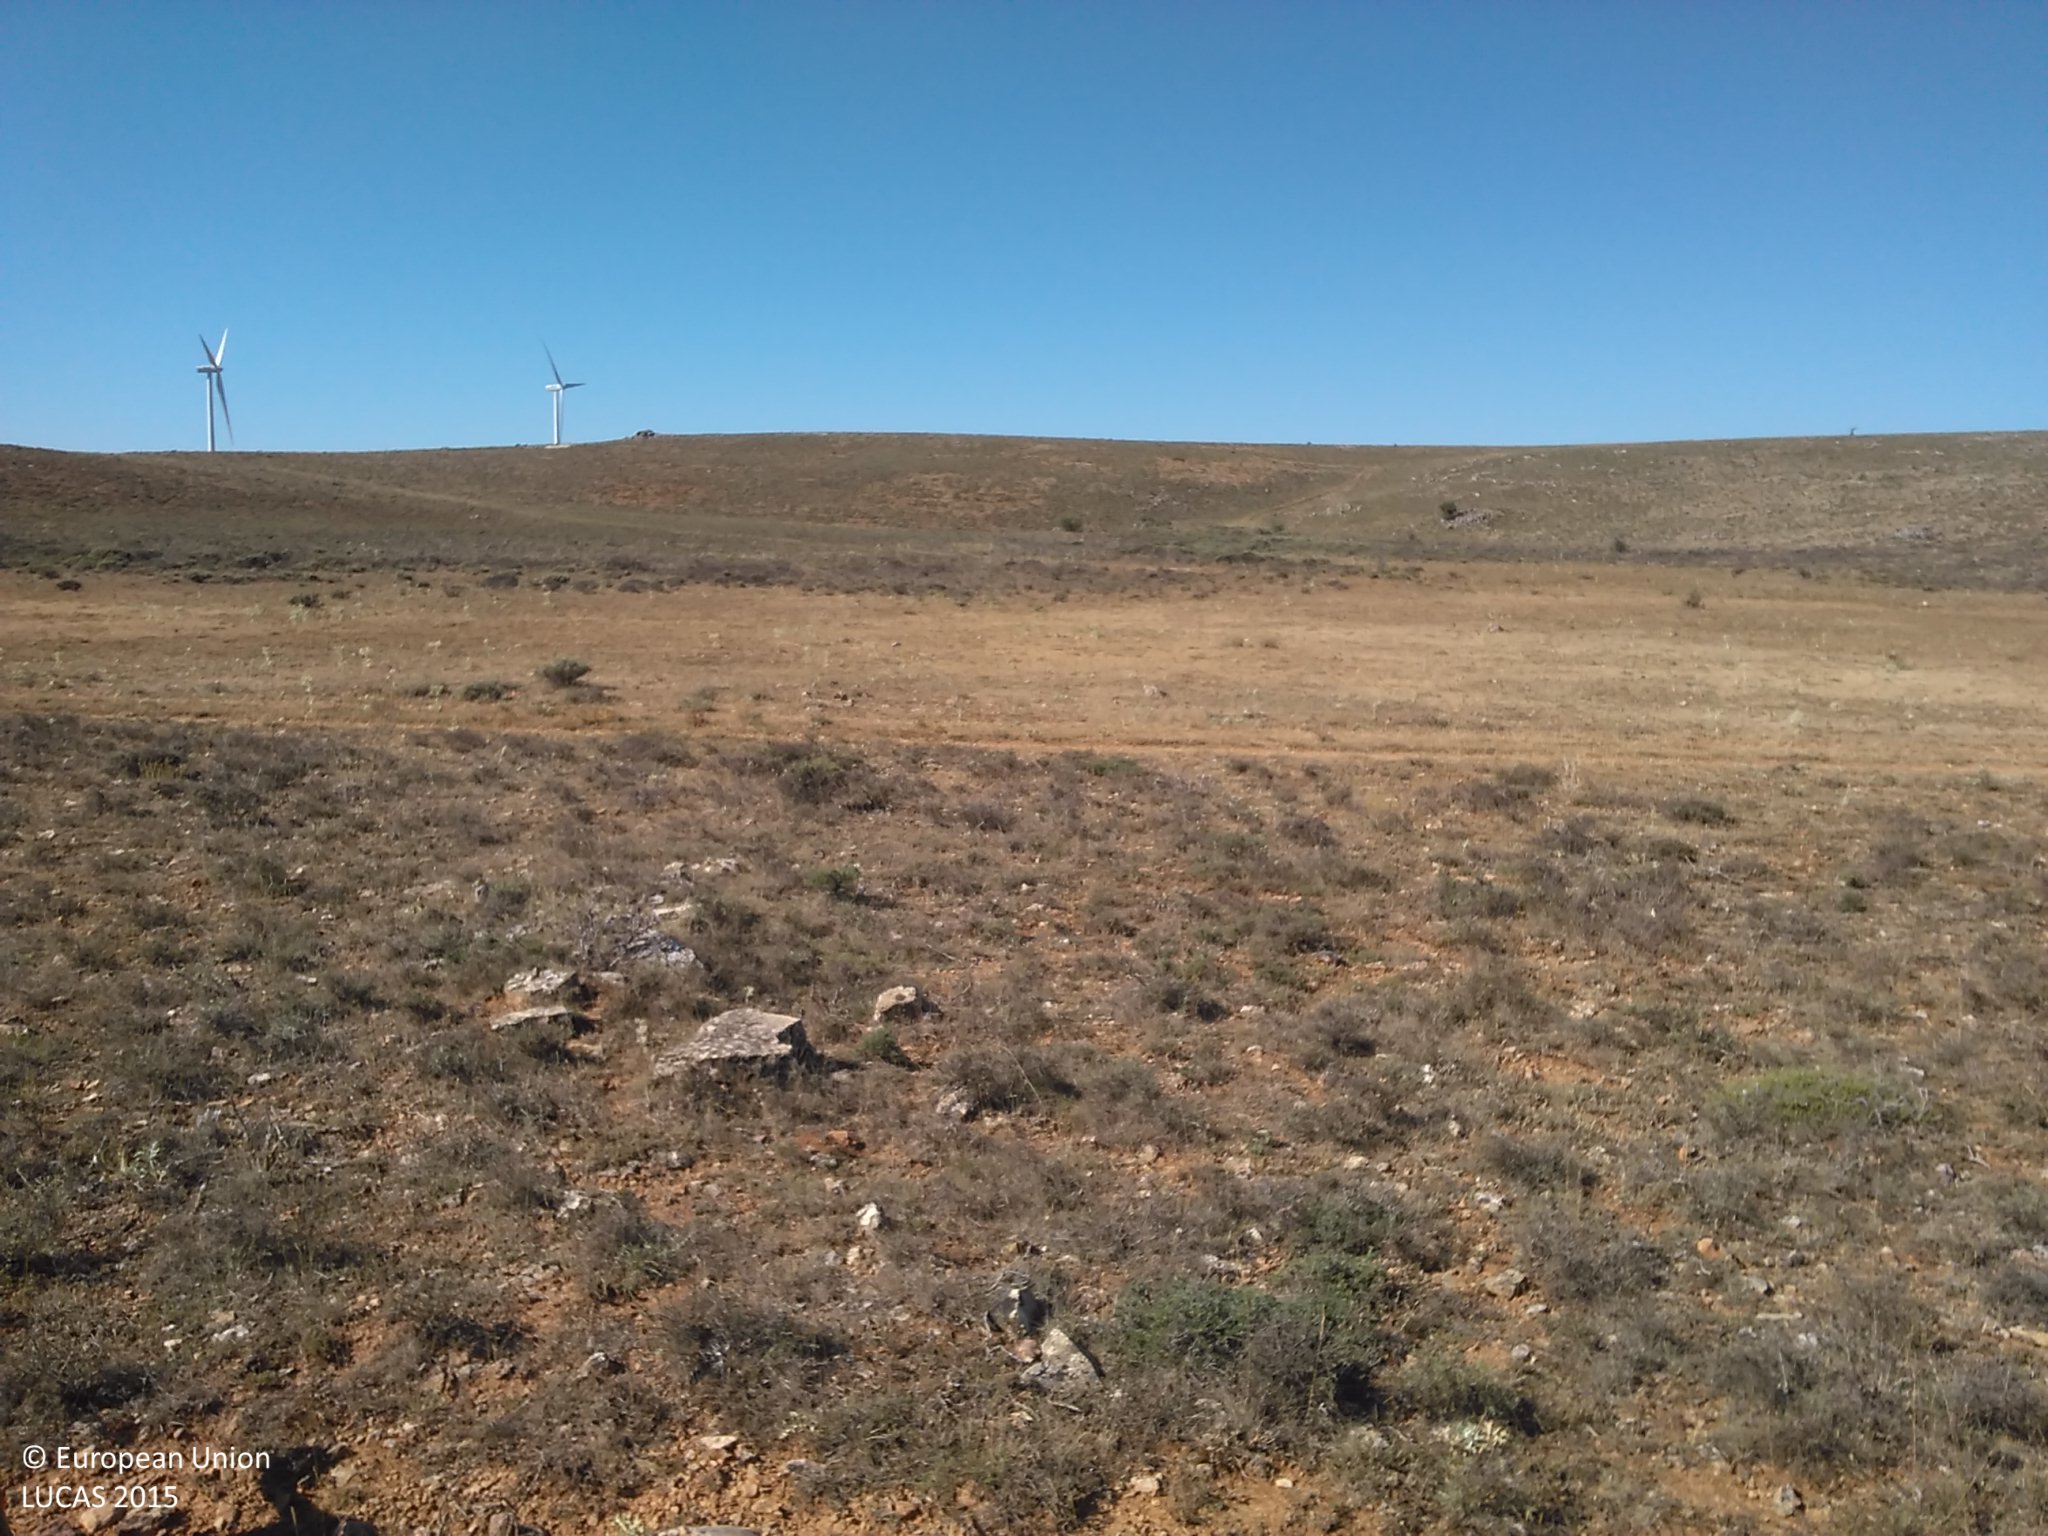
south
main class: Shrubland
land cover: Shrubland without tree cover
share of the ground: 50 - 75 %
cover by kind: shrubs 60 %, unconsolidated bare surface 40 %
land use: Semi-natural and natural areas not in use
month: July
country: ES
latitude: 41.2893
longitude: -2.9465
